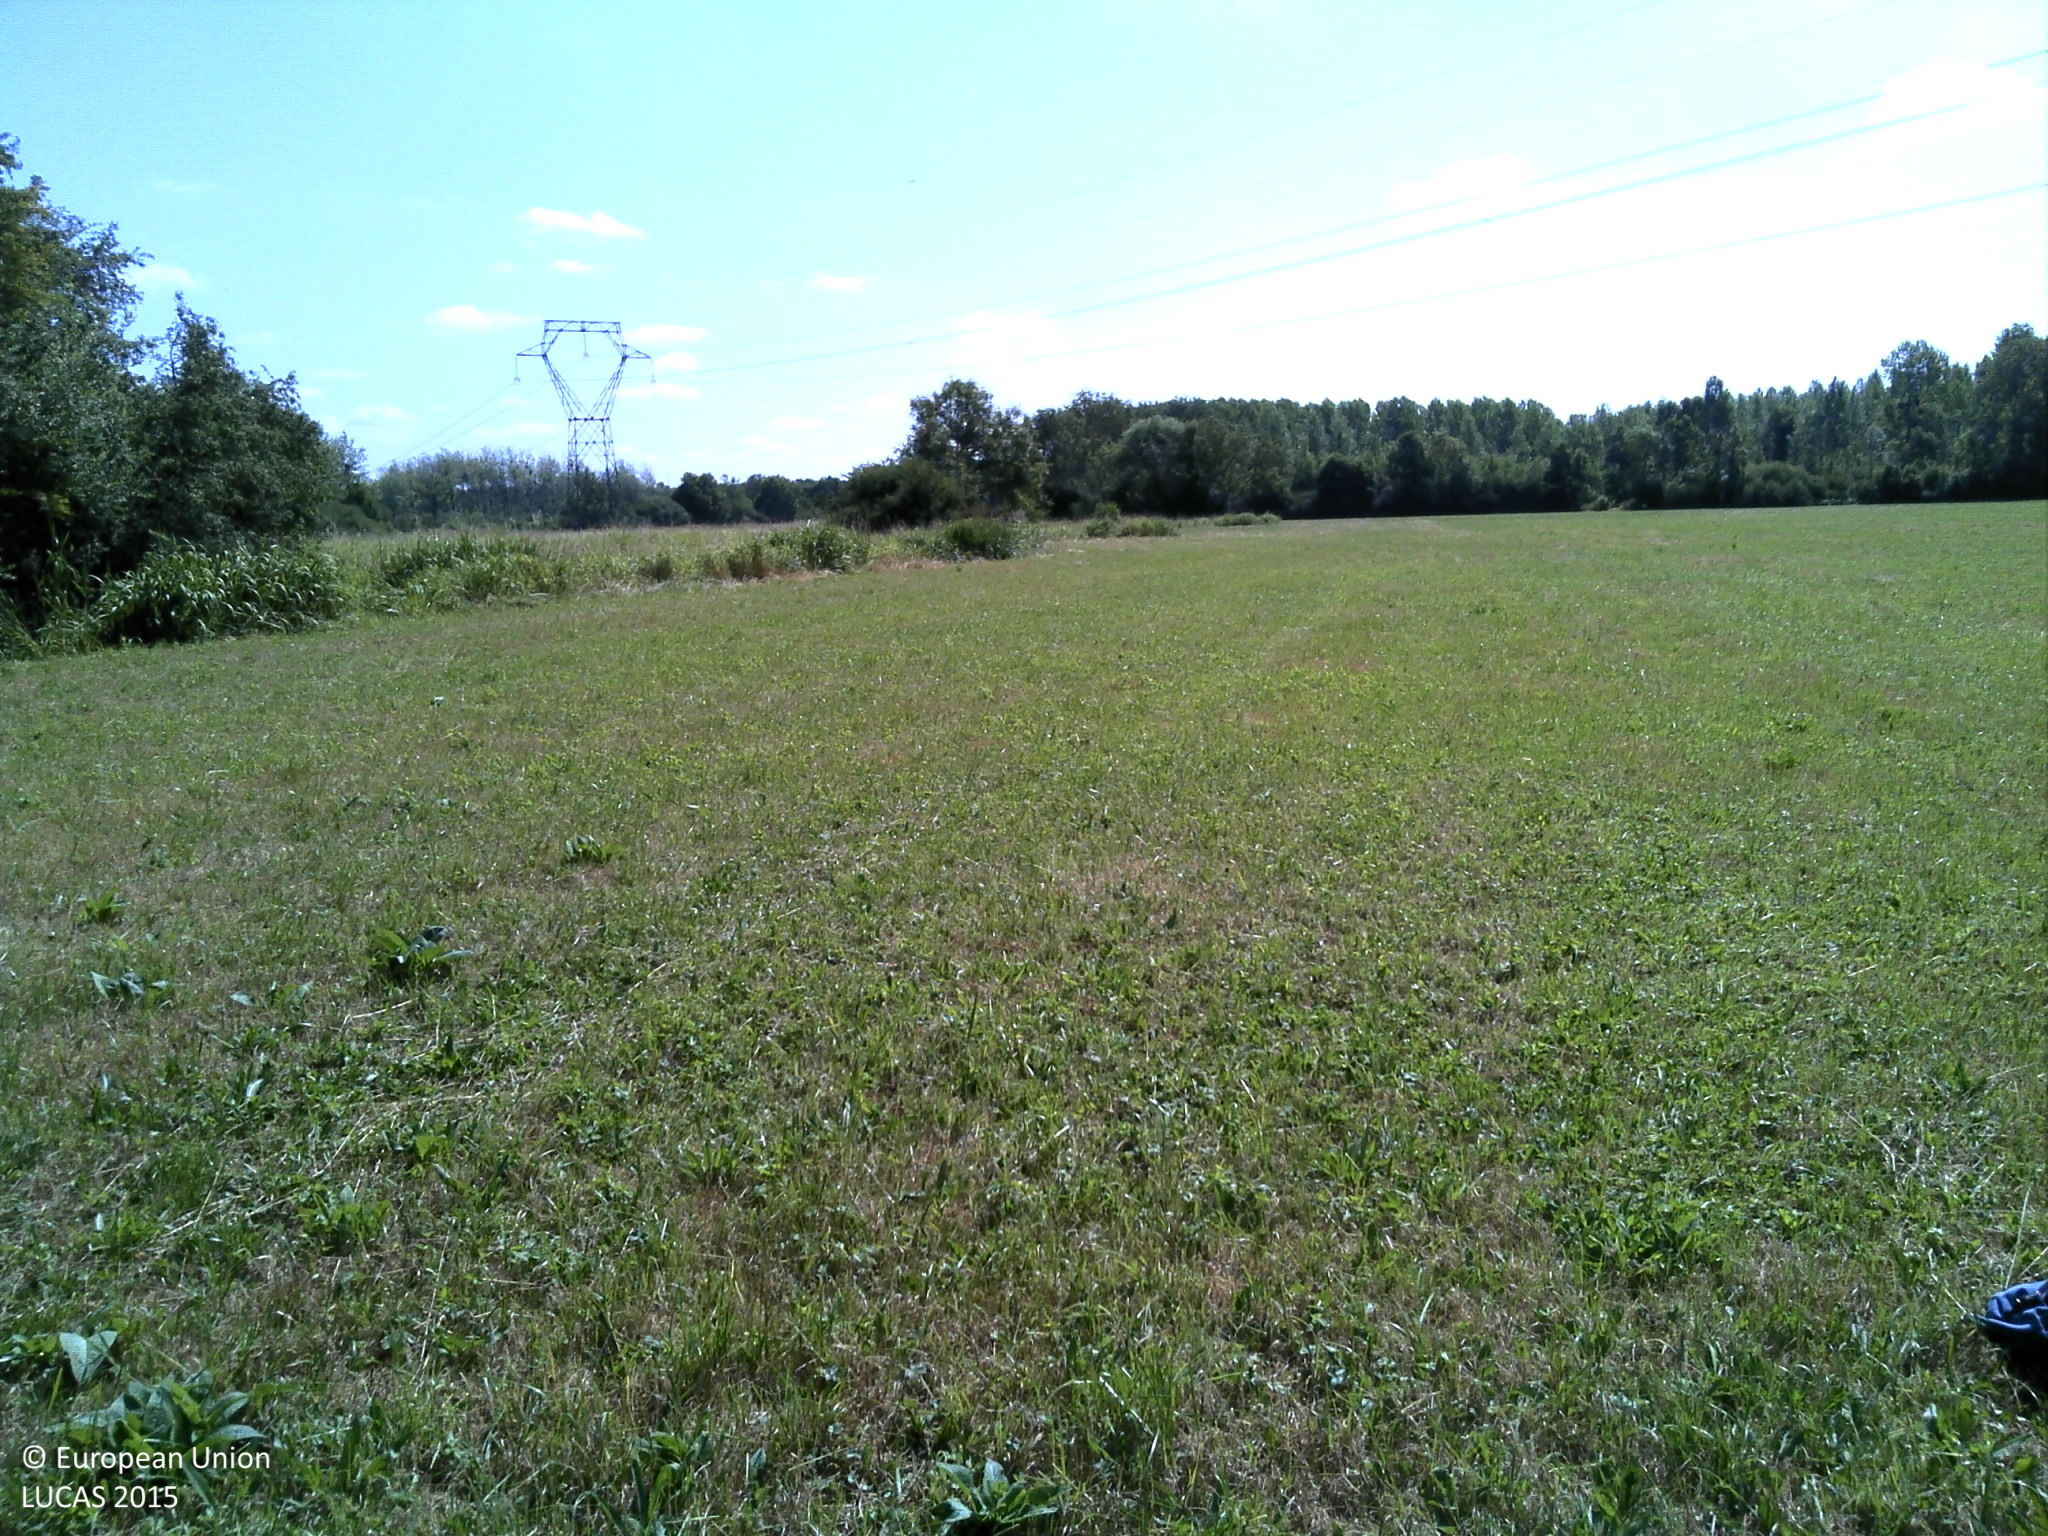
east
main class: Grassland
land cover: Grassland without tree/shrub cover
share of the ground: > 75 %
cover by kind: herbaceous plants 100 %
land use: Agriculture (excluding fallow land and kitchen gardens)
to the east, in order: Grassland without tree/shrub cover; Spontaneously vegetated surfaces; Ditches and canals; Spontaneously vegetated surfaces; Electric lines; Spontaneously vegetated surfaces
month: July
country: FR
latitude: 48.6738
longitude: 4.7148
